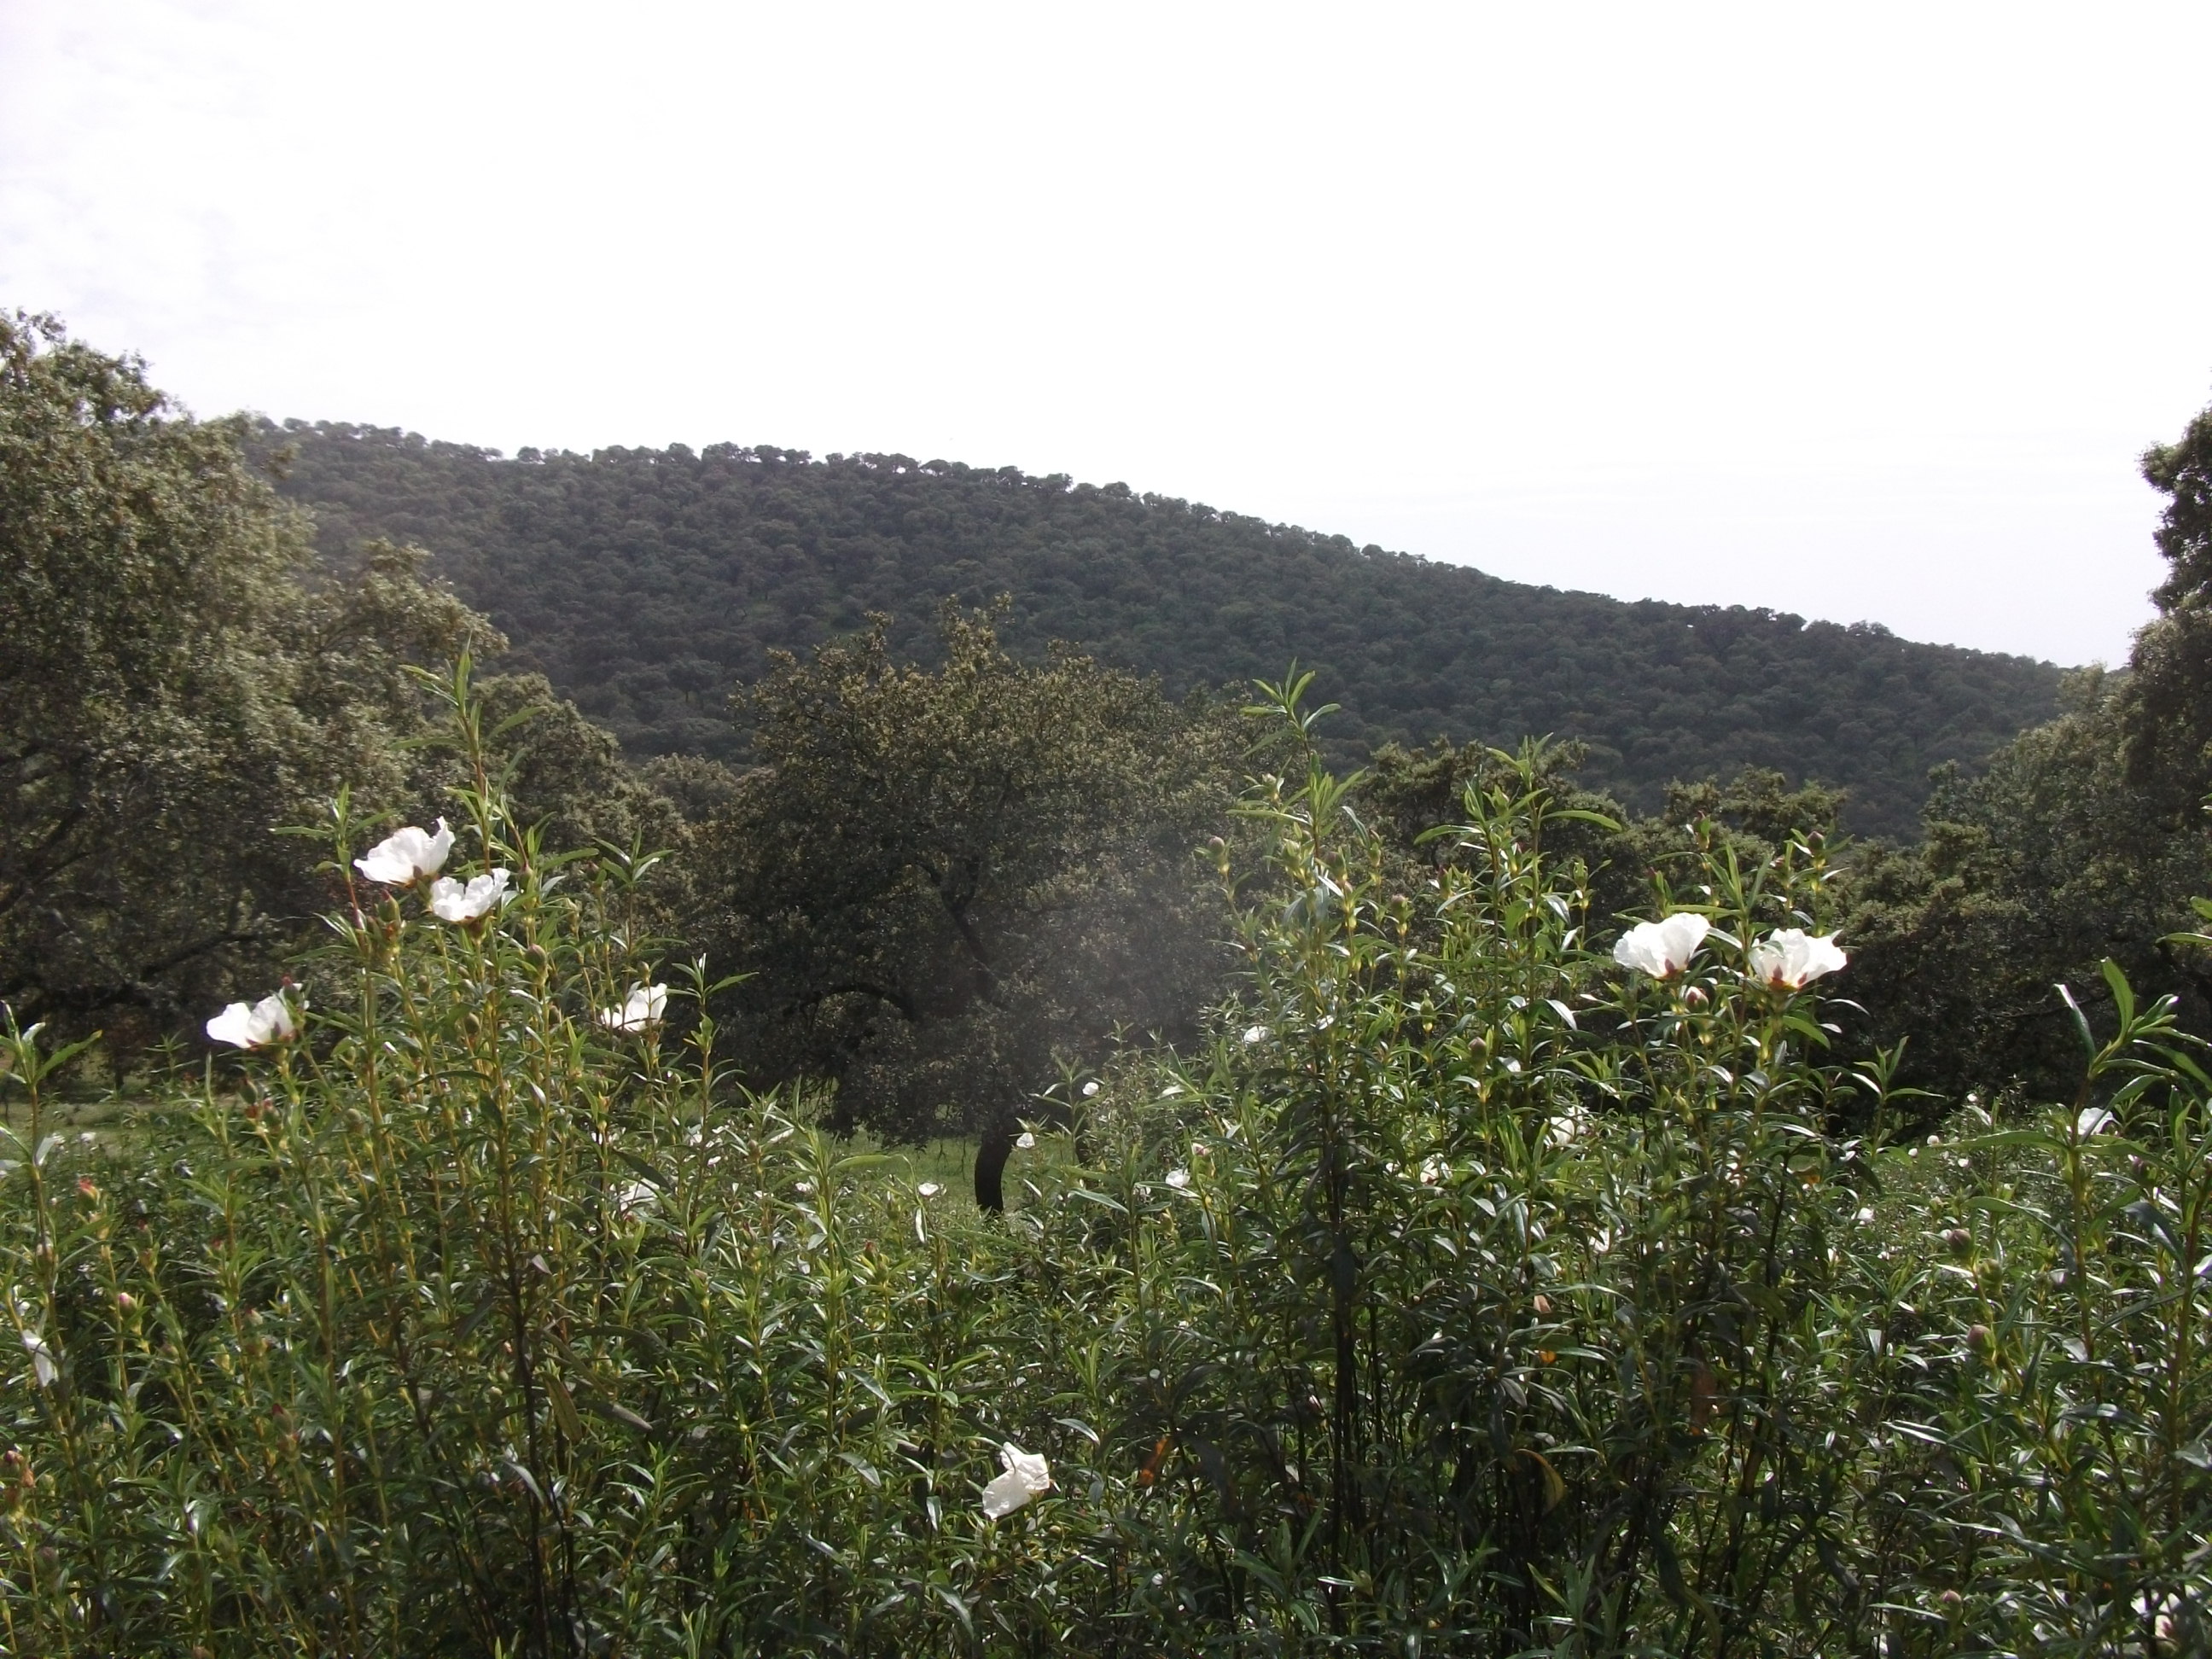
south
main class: Shrubland
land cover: Shrubland with sparse tree cover
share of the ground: > 75 %
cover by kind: shrubs 80 %, herbaceous plants 15 %, broadleaved forest trees 5 %
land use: Agriculture (excluding fallow land and kitchen gardens)
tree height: > 5 m
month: April
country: ES
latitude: 37.8265
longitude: -6.7119
